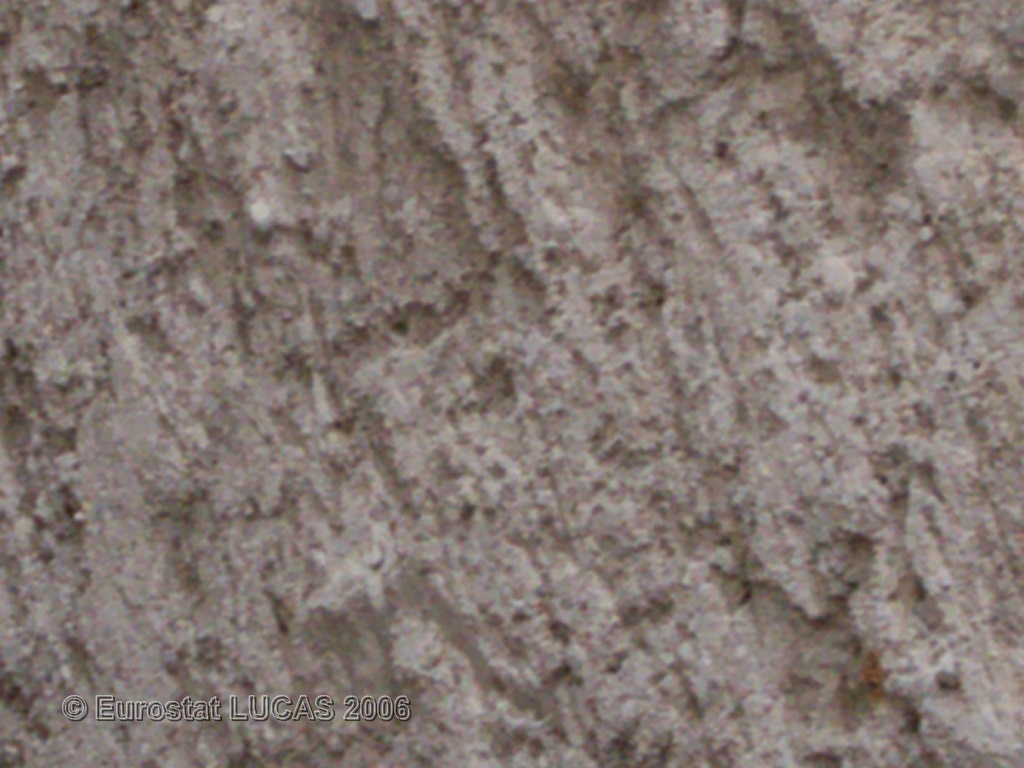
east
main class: Grassland
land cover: Grassland with sparse tree/shrub cover
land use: Residential
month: April
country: FR
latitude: 48.6711
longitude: 7.0811
